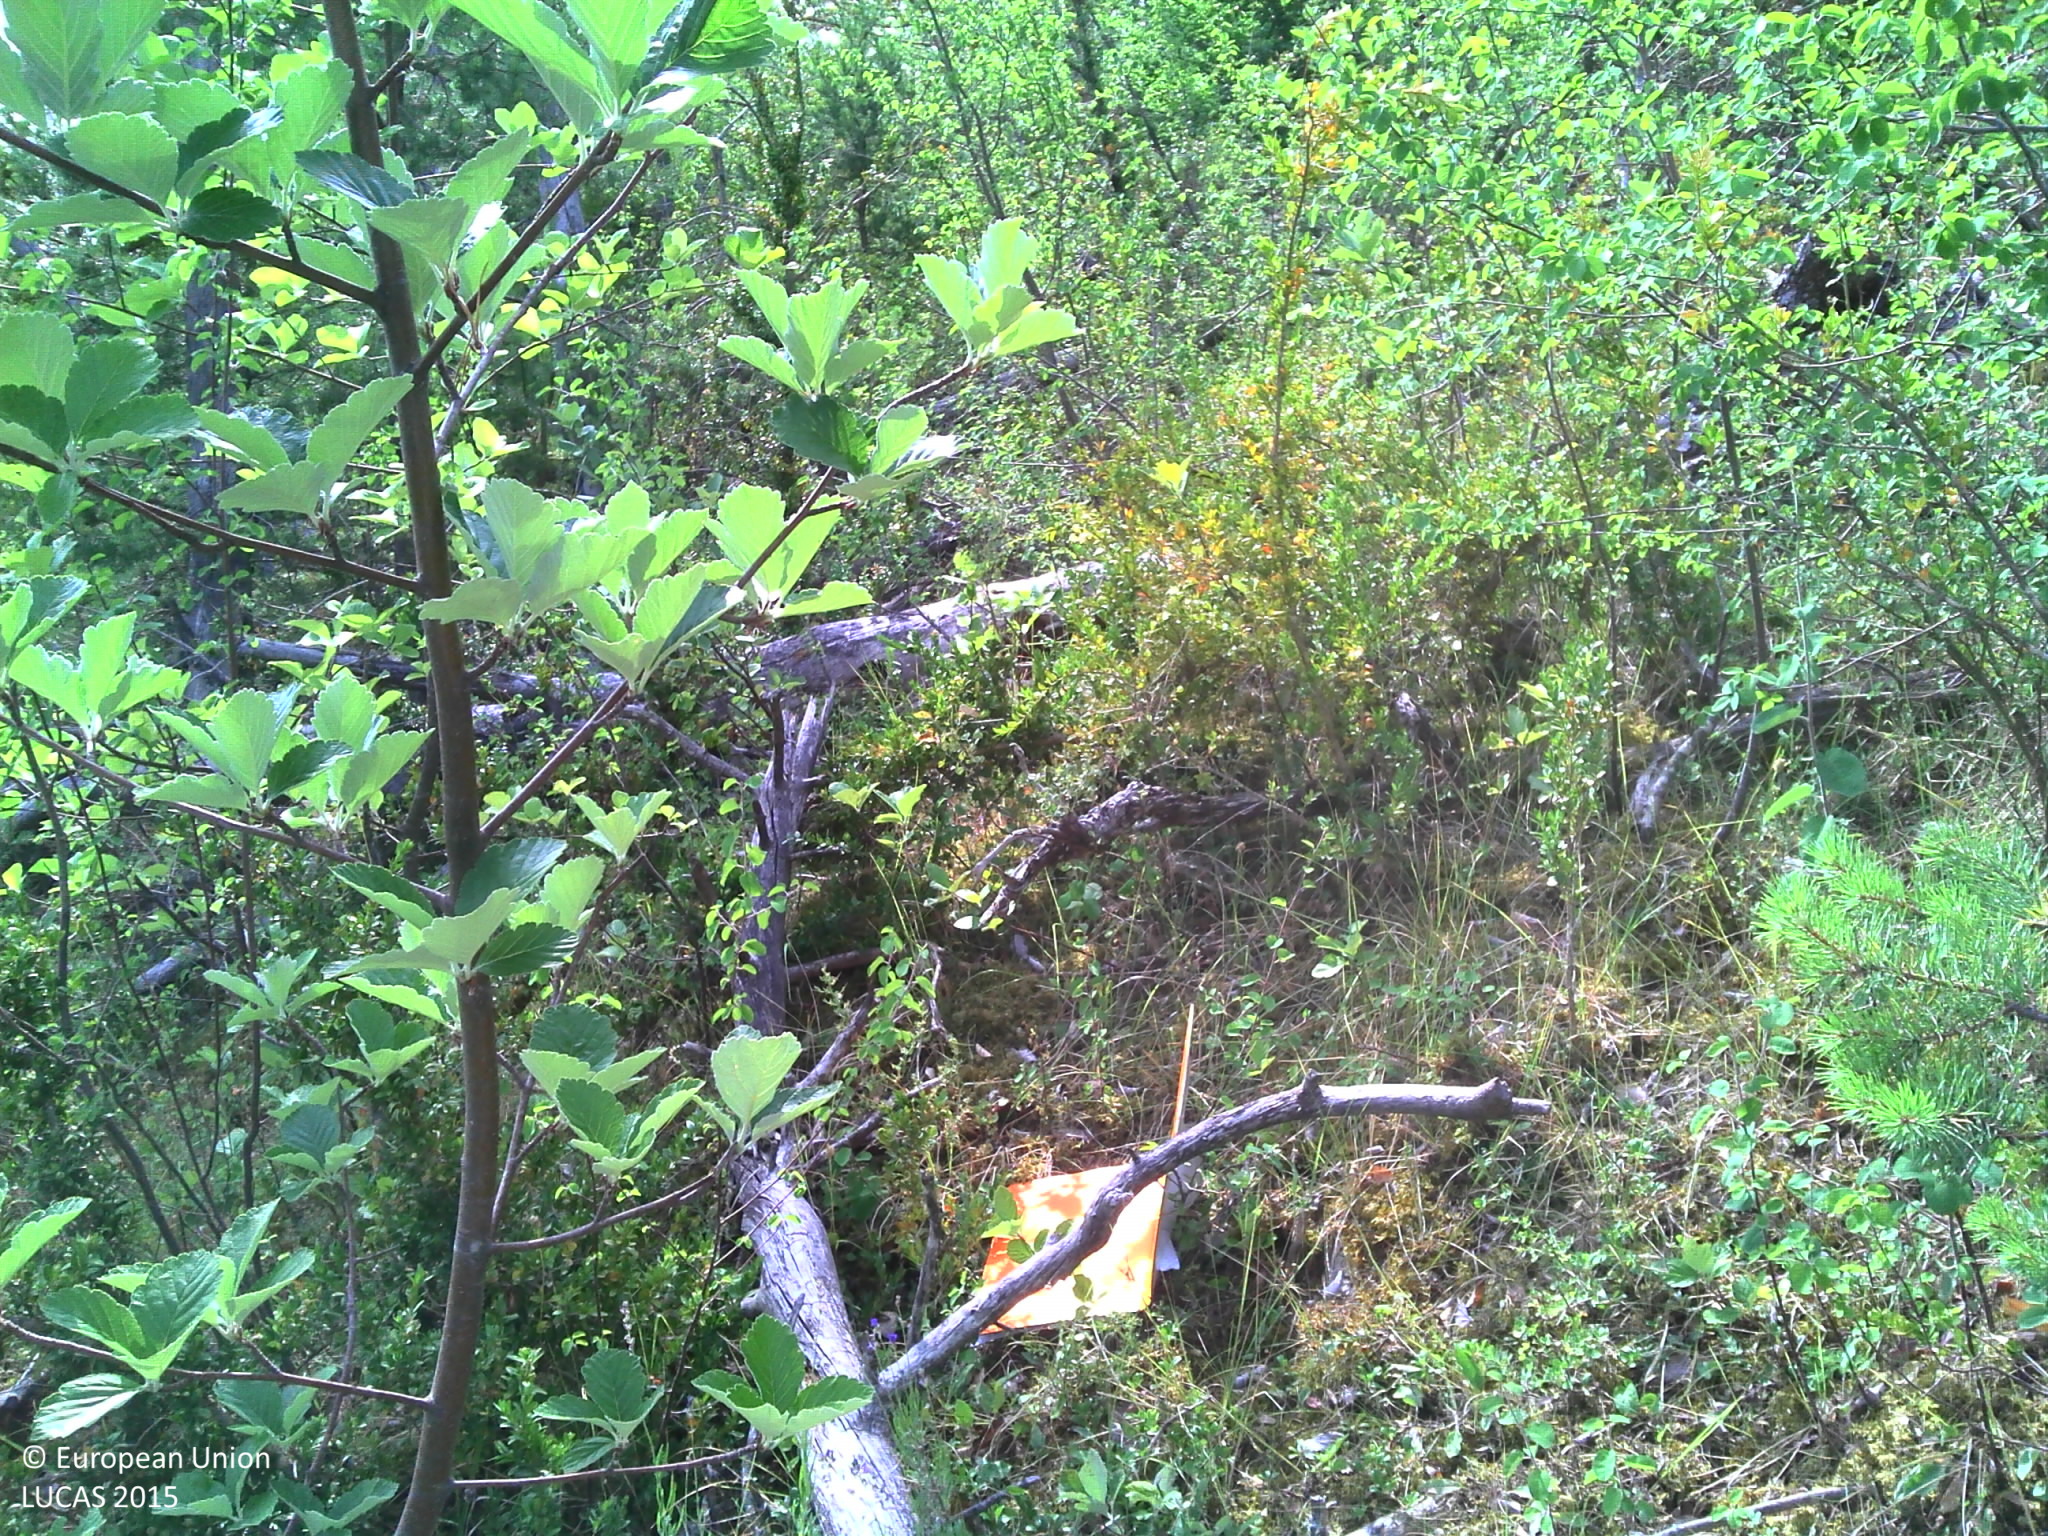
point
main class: Woodland
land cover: Pine dominated mixed woodland
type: coniferous forest of the mediterranean region
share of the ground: 50 - 75 %
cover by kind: coniferous forest trees 40 %, broadleaved forest trees 20 %, herbaceous plants 20 %, shrubs 10 %, lichens and mosses 10 %
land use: Forestry
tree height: > 5 m
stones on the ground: 25 - 50 %
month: July
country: FR
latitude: 43.7977
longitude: 6.3168
